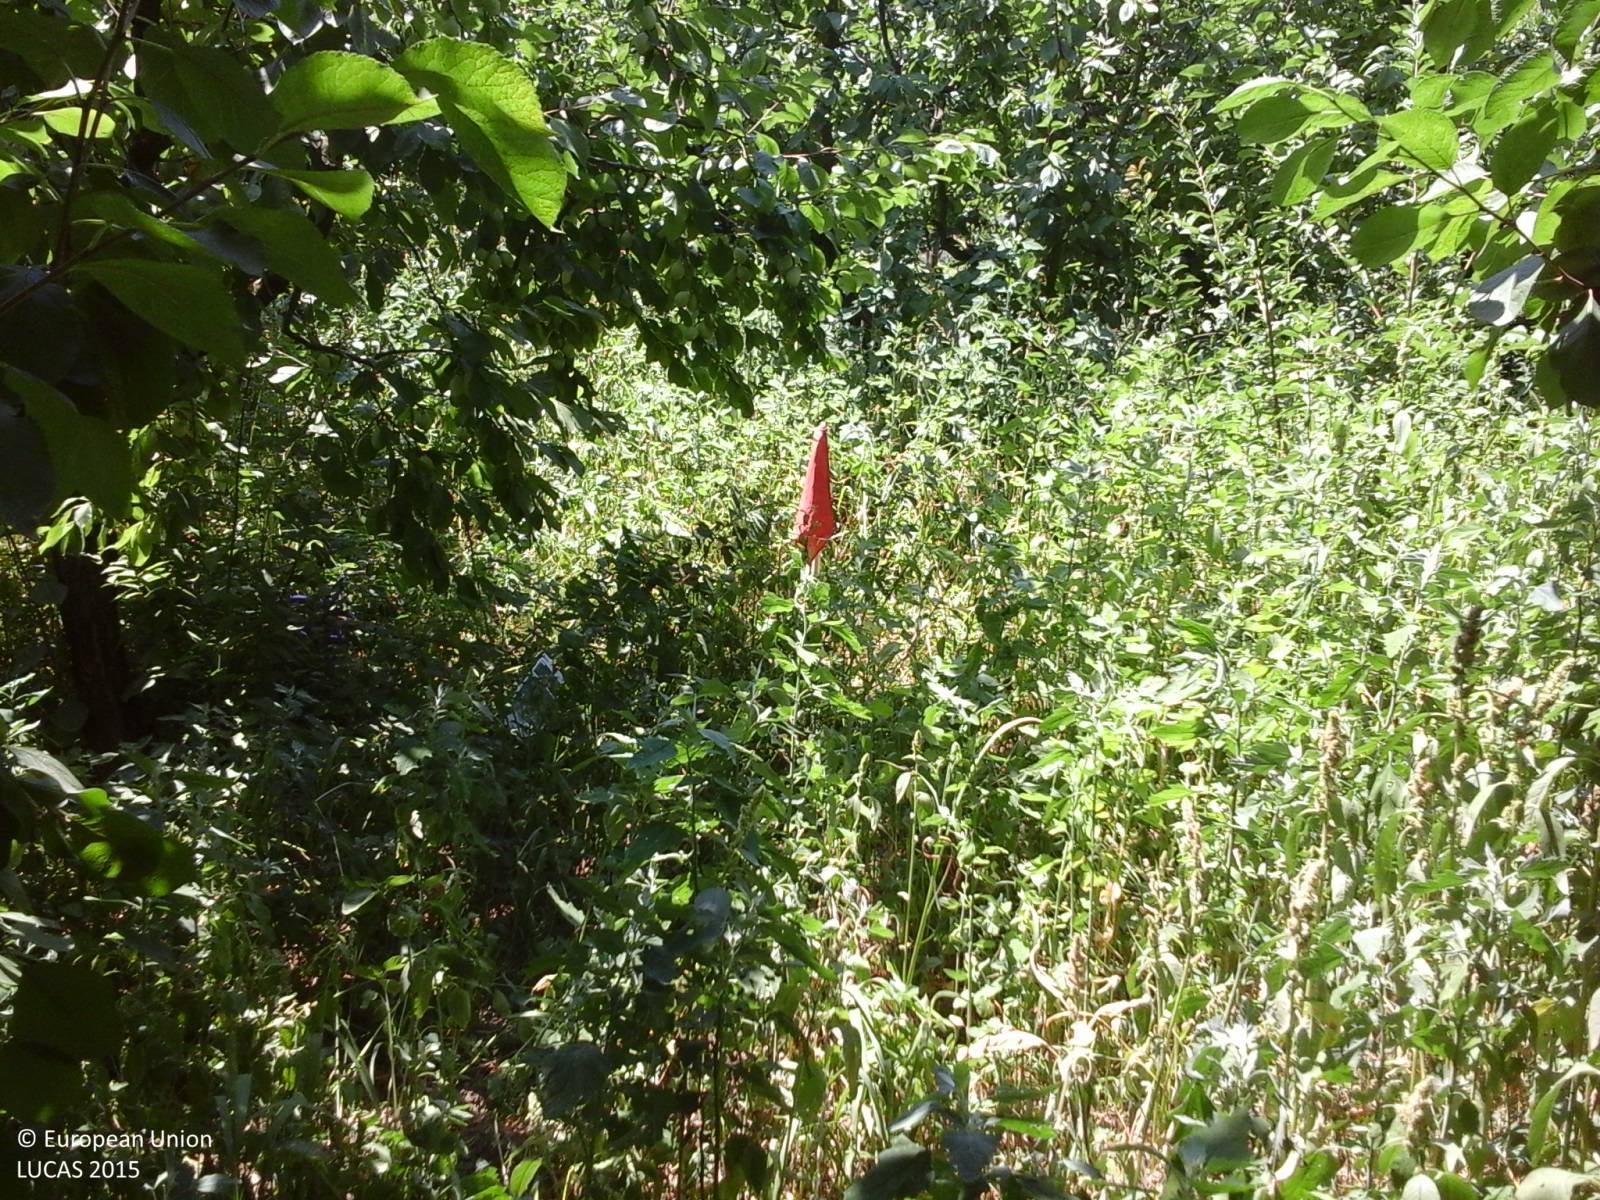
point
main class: Cropland
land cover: Other fruit trees and berries
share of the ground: > 75 %
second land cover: Spontaneously vegetated surfaces
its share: > 75 %
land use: Agriculture (excluding fallow land and kitchen gardens)
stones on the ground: < 10 %
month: July
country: IT
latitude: 40.8861
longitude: 14.1484
